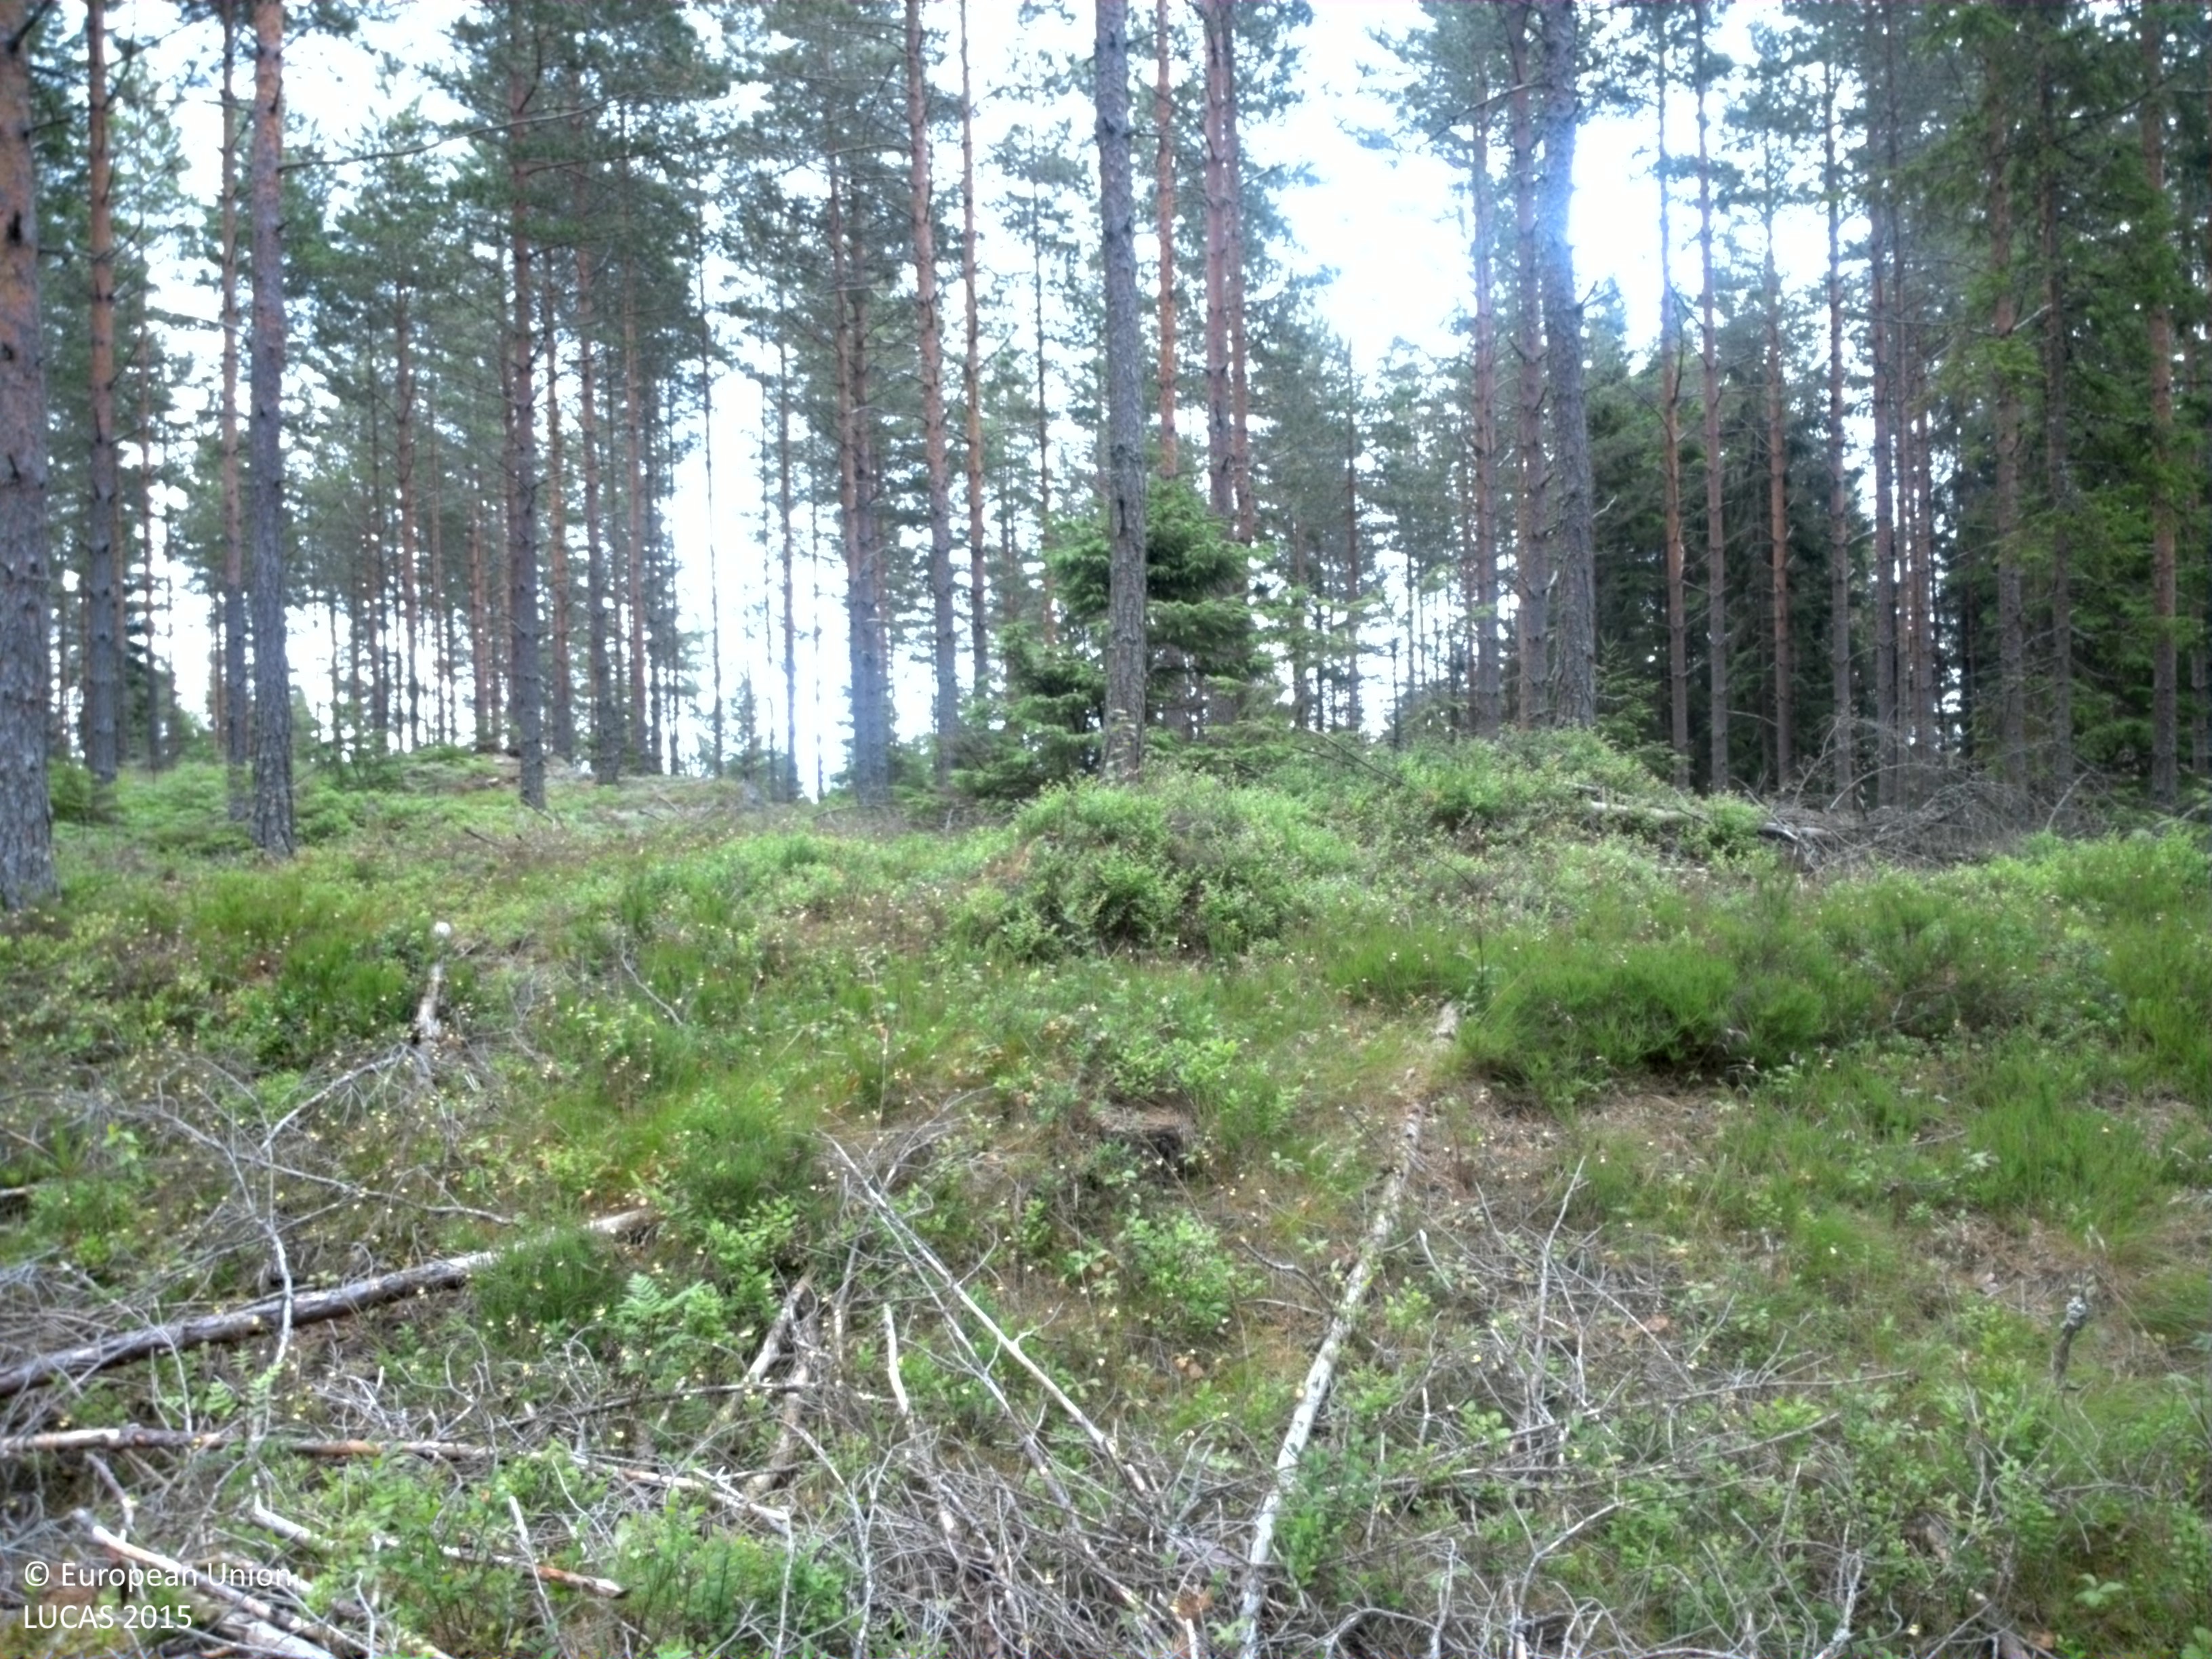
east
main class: Woodland
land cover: Pine dominated coniferous woodland
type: boreal forest
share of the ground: 50 - 75 %
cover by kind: coniferous forest trees 65 %, shrubs 20 %, lichens and mosses 10 %, herbaceous plants 5 %
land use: Forestry
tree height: > 5 m
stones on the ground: < 10 %
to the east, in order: Pine dominated coniferous woodland; Spruce dominated coniferous woodland; Pine dominated coniferous woodland; Spruce dominated mixed woodland; Tracks; Spruce dominated mixed woodland; Shrubland with sparse tree cover; Inland marshes; Inland fresh water bodies
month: July
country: SE
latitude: 59.5577
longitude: 11.7470
